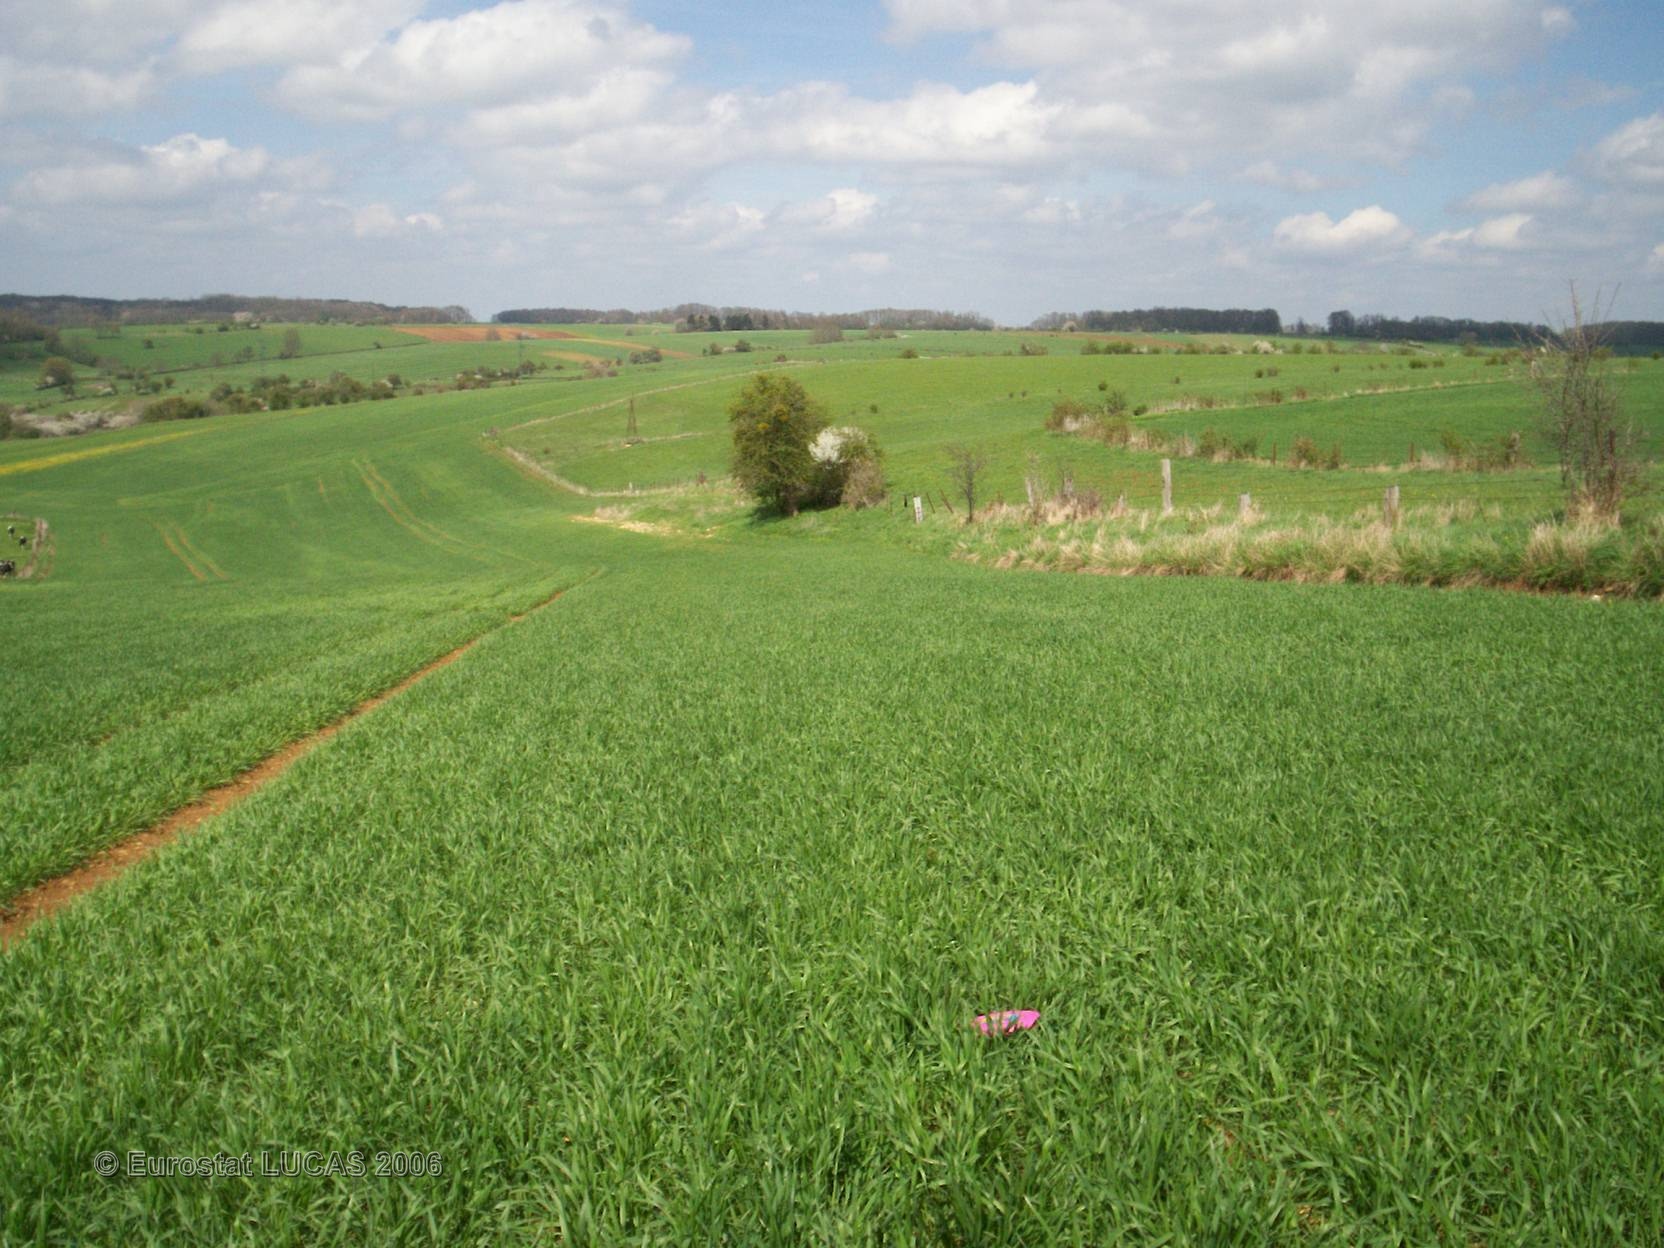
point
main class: Cropland
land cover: Common wheat
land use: Agriculture (excluding fallow land and kitchen gardens)
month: May
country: FR
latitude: 49.8121
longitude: 4.3953
